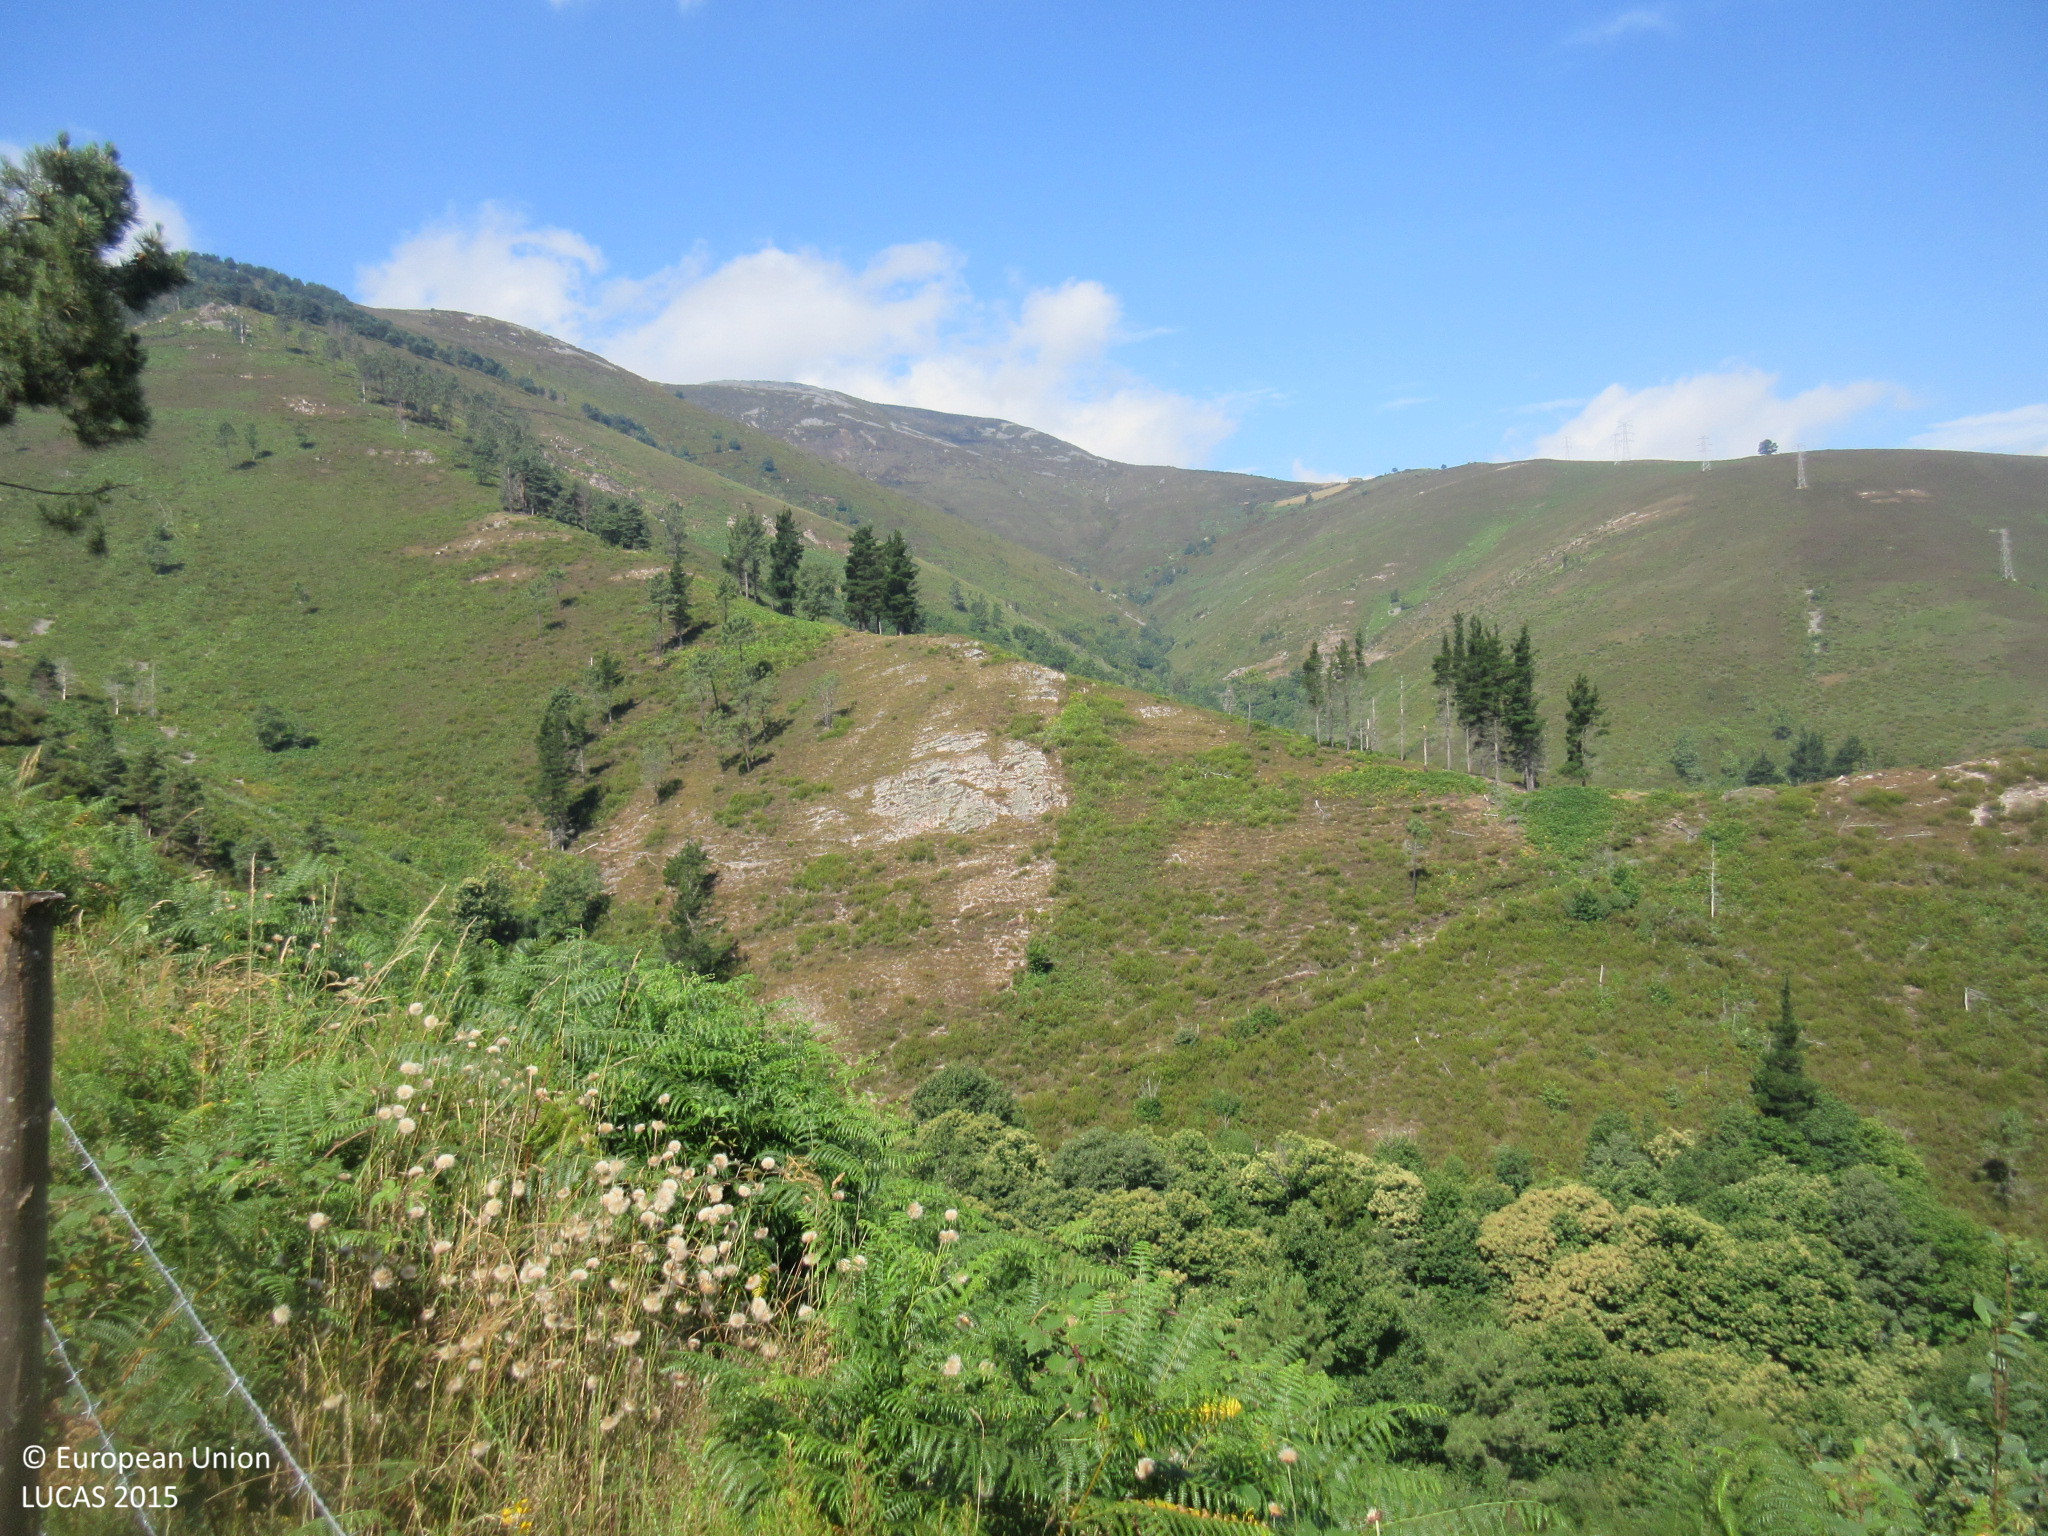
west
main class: Woodland
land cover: Broadleaved woodland
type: acidophilous oak and oak-birch forest
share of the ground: > 75 %
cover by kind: broadleaved forest trees 95 %, shrubs 5 %
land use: Forestry
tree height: > 5 m
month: July
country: ES
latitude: 43.2733
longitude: -6.6282
